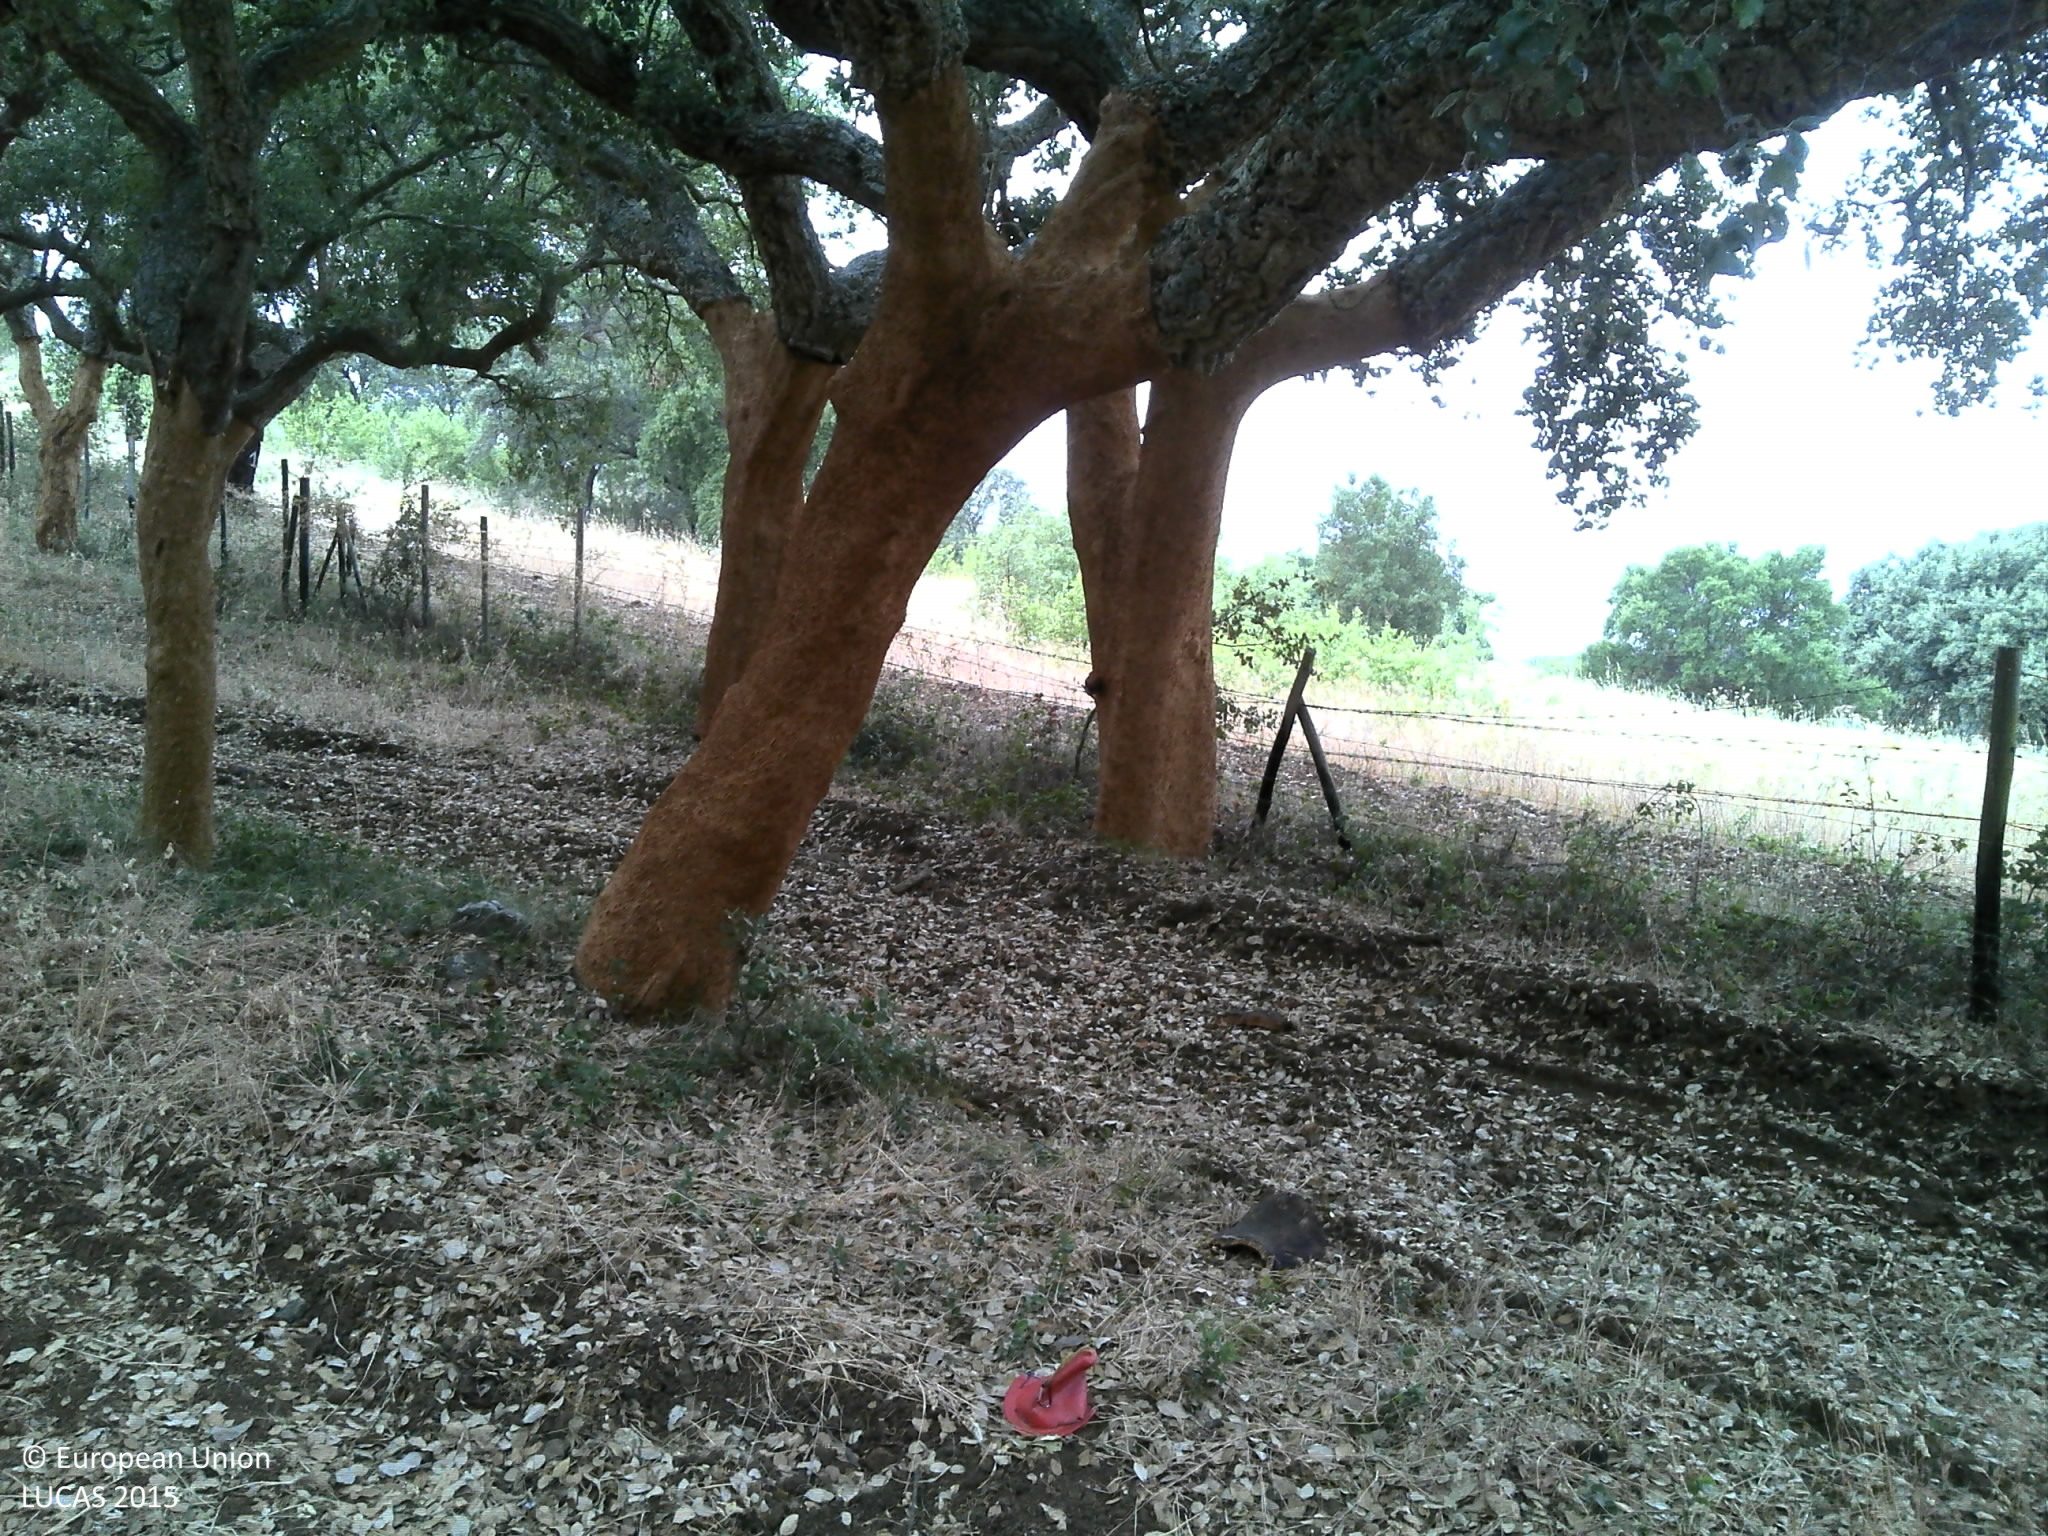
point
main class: Woodland
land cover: Broadleaved woodland
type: broadleaved evergreen forest
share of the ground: 50 - 75 %
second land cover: Grassland without tree/shrub cover
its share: 10 - 25 %
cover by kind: broadleaved forest trees 75 %, herbaceous plants 15 %, unconsolidated bare surface 10 %
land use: Forestry
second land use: Agriculture (excluding fallow land and kitchen gardens)
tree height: > 5 m
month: June
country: PT
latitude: 38.3569
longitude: -7.9458
